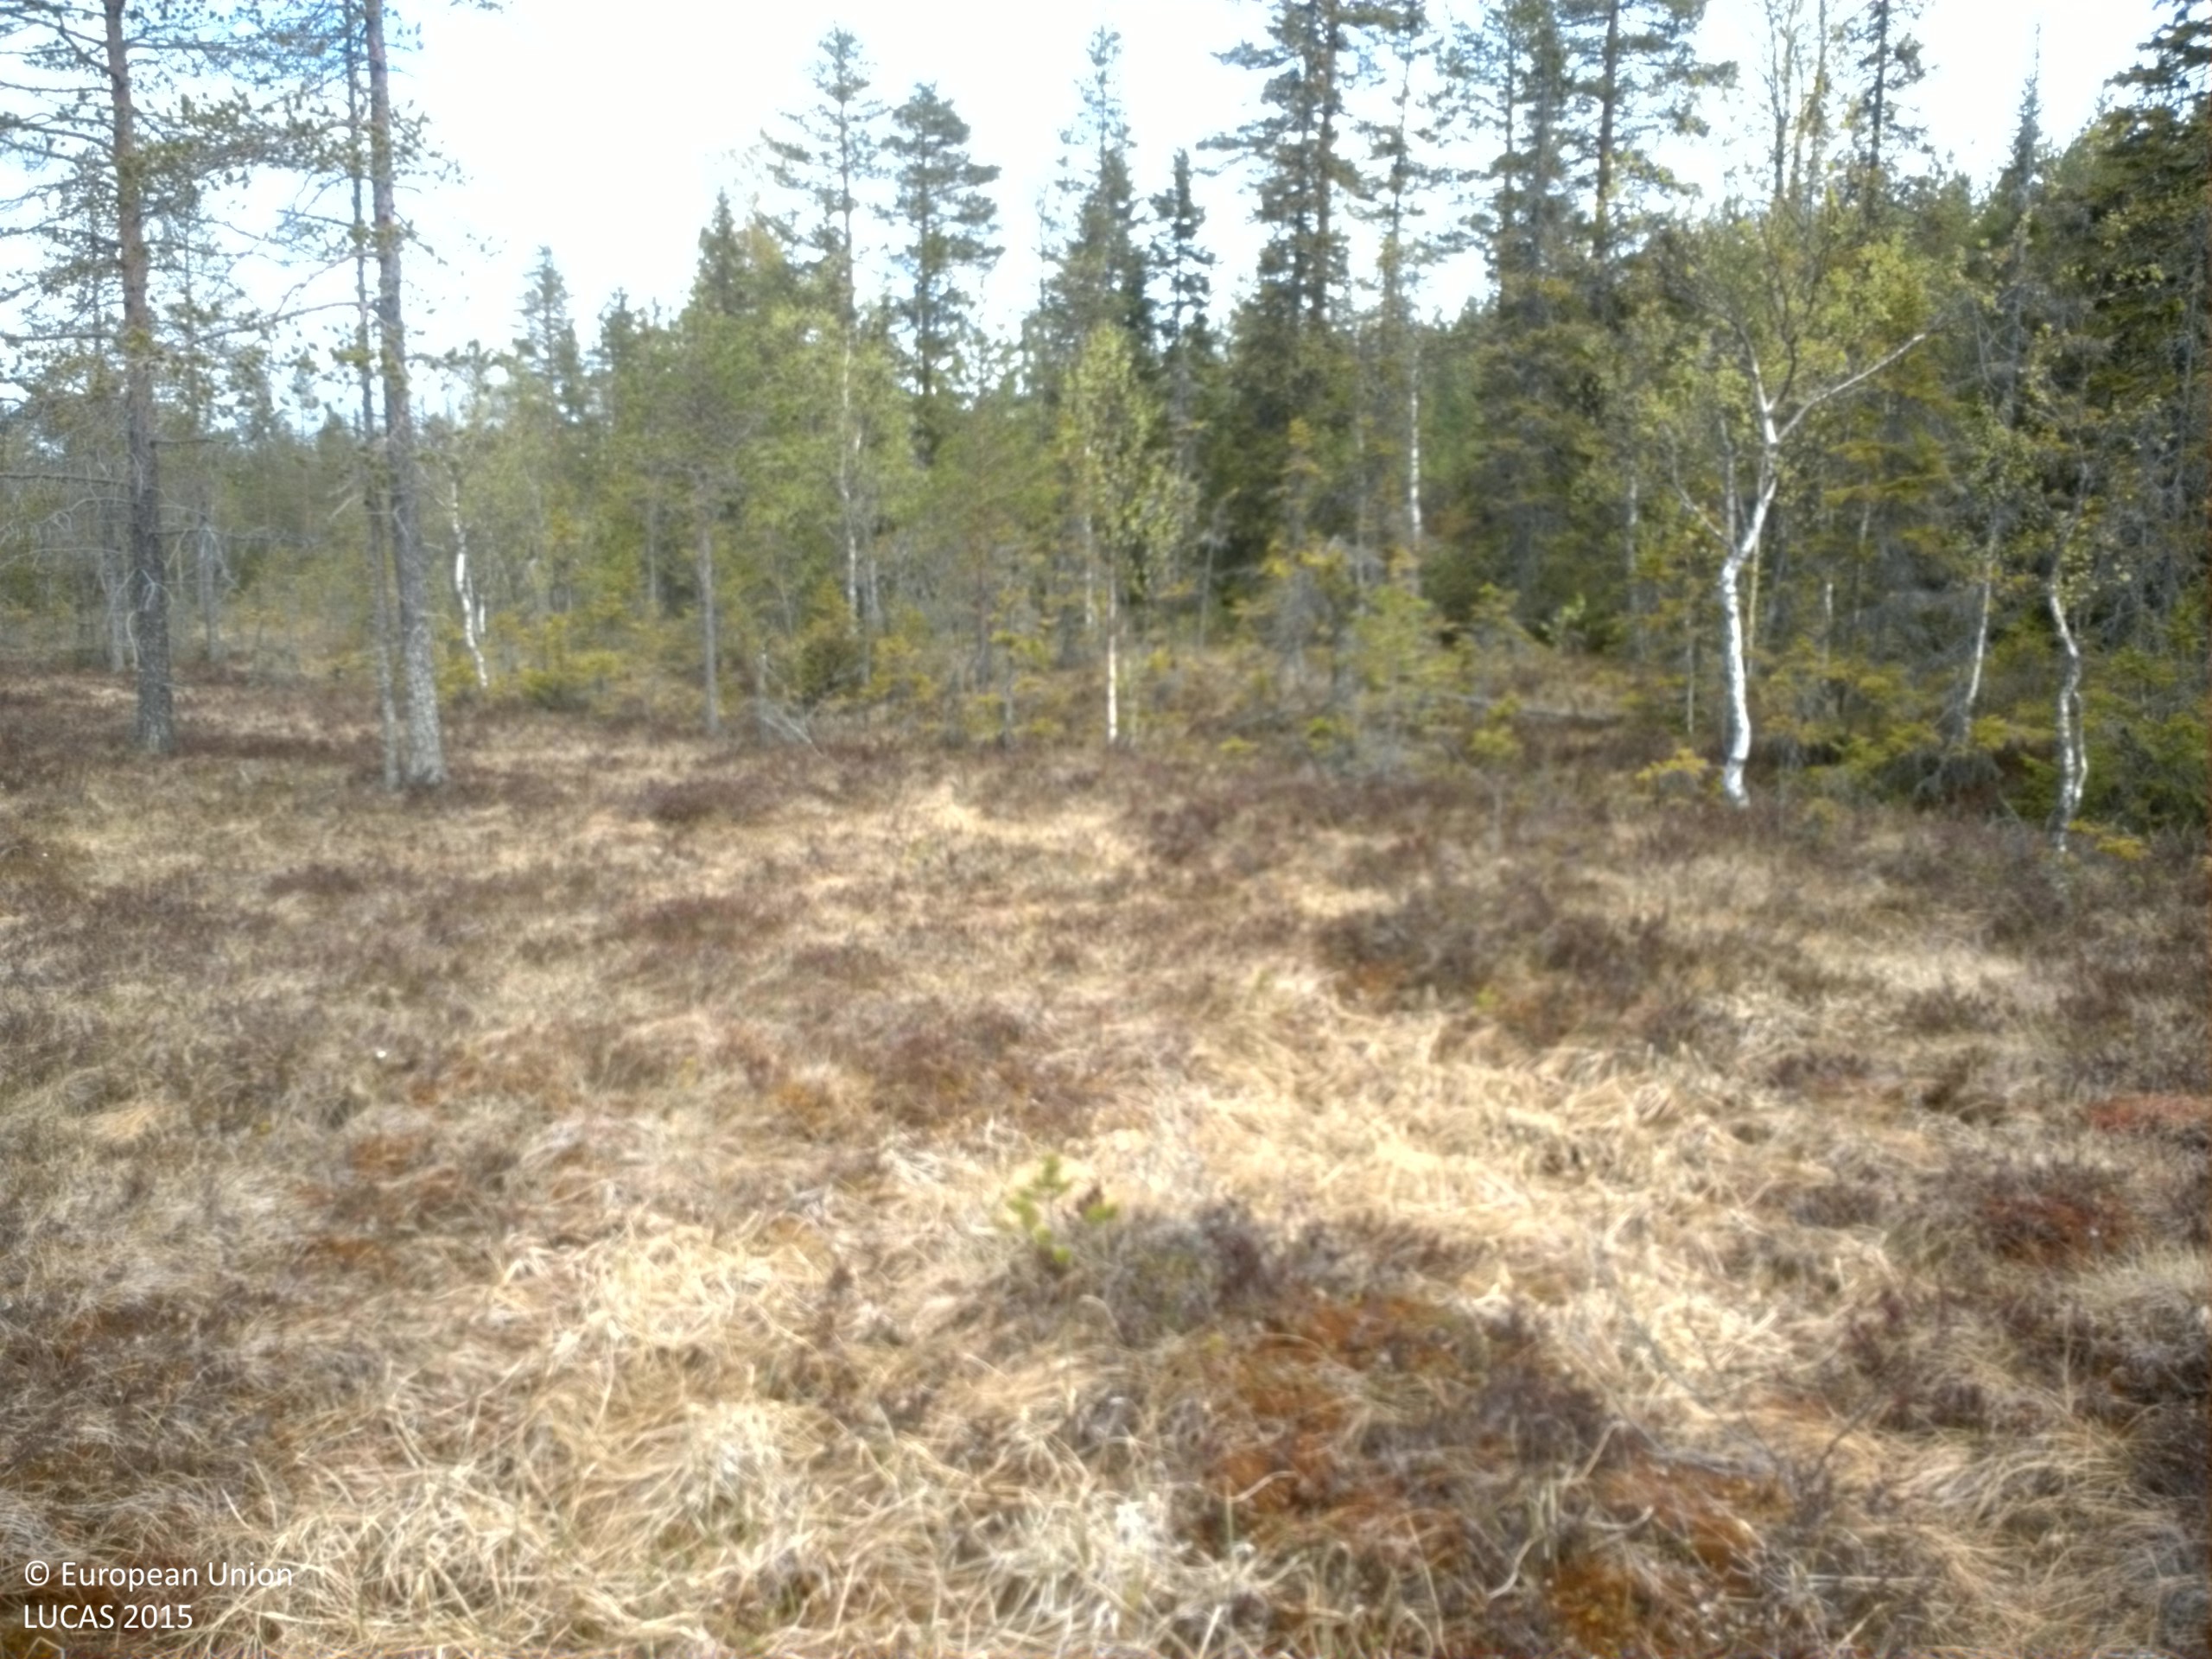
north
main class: Shrubland
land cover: Shrubland with sparse tree cover
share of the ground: 50 - 75 %
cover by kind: shrubs 70 %, herbaceous plants 25 %, coniferous forest trees 5 %
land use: Semi-natural and natural areas not in use
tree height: > 5 m
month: June
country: SE
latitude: 62.9147
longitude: 17.1233
